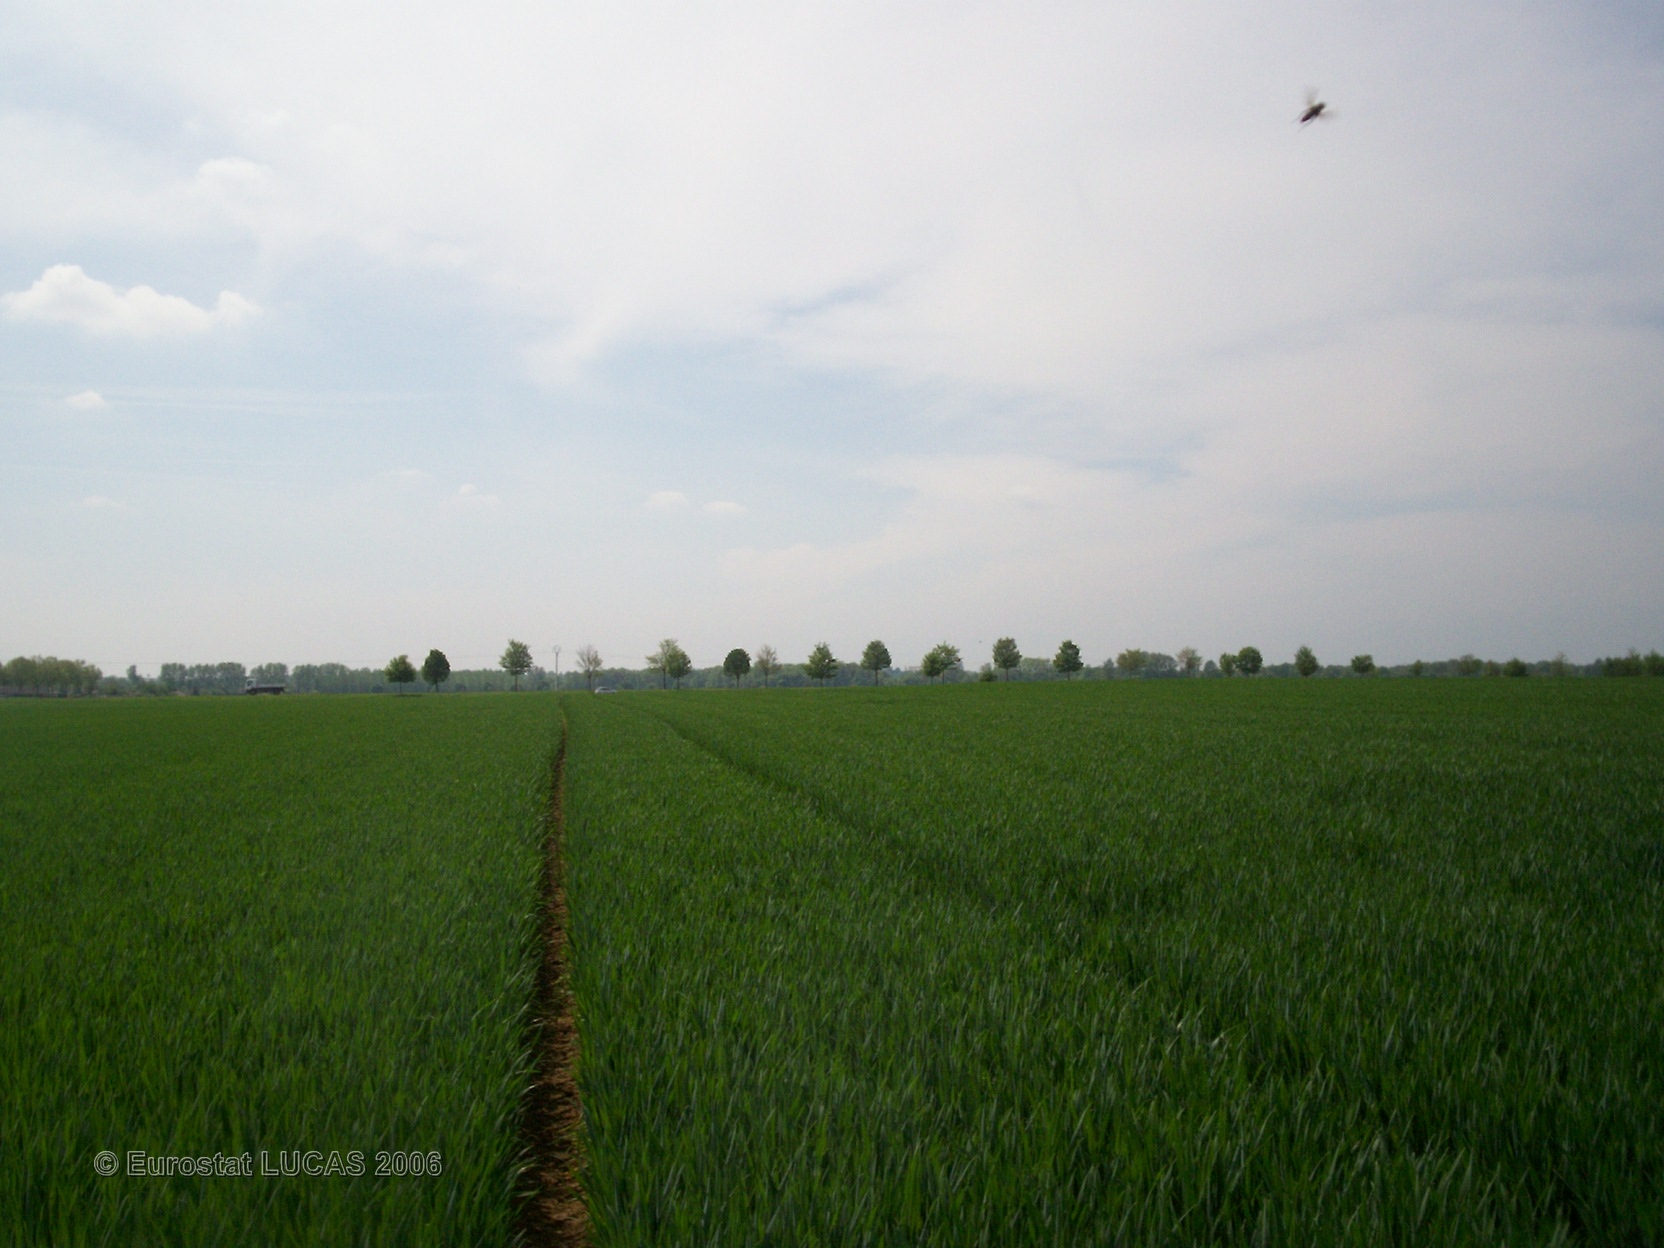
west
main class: Cropland
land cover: Common wheat
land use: Agriculture (excluding fallow land and kitchen gardens)
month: May
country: FR
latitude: 48.9296
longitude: 4.4138
